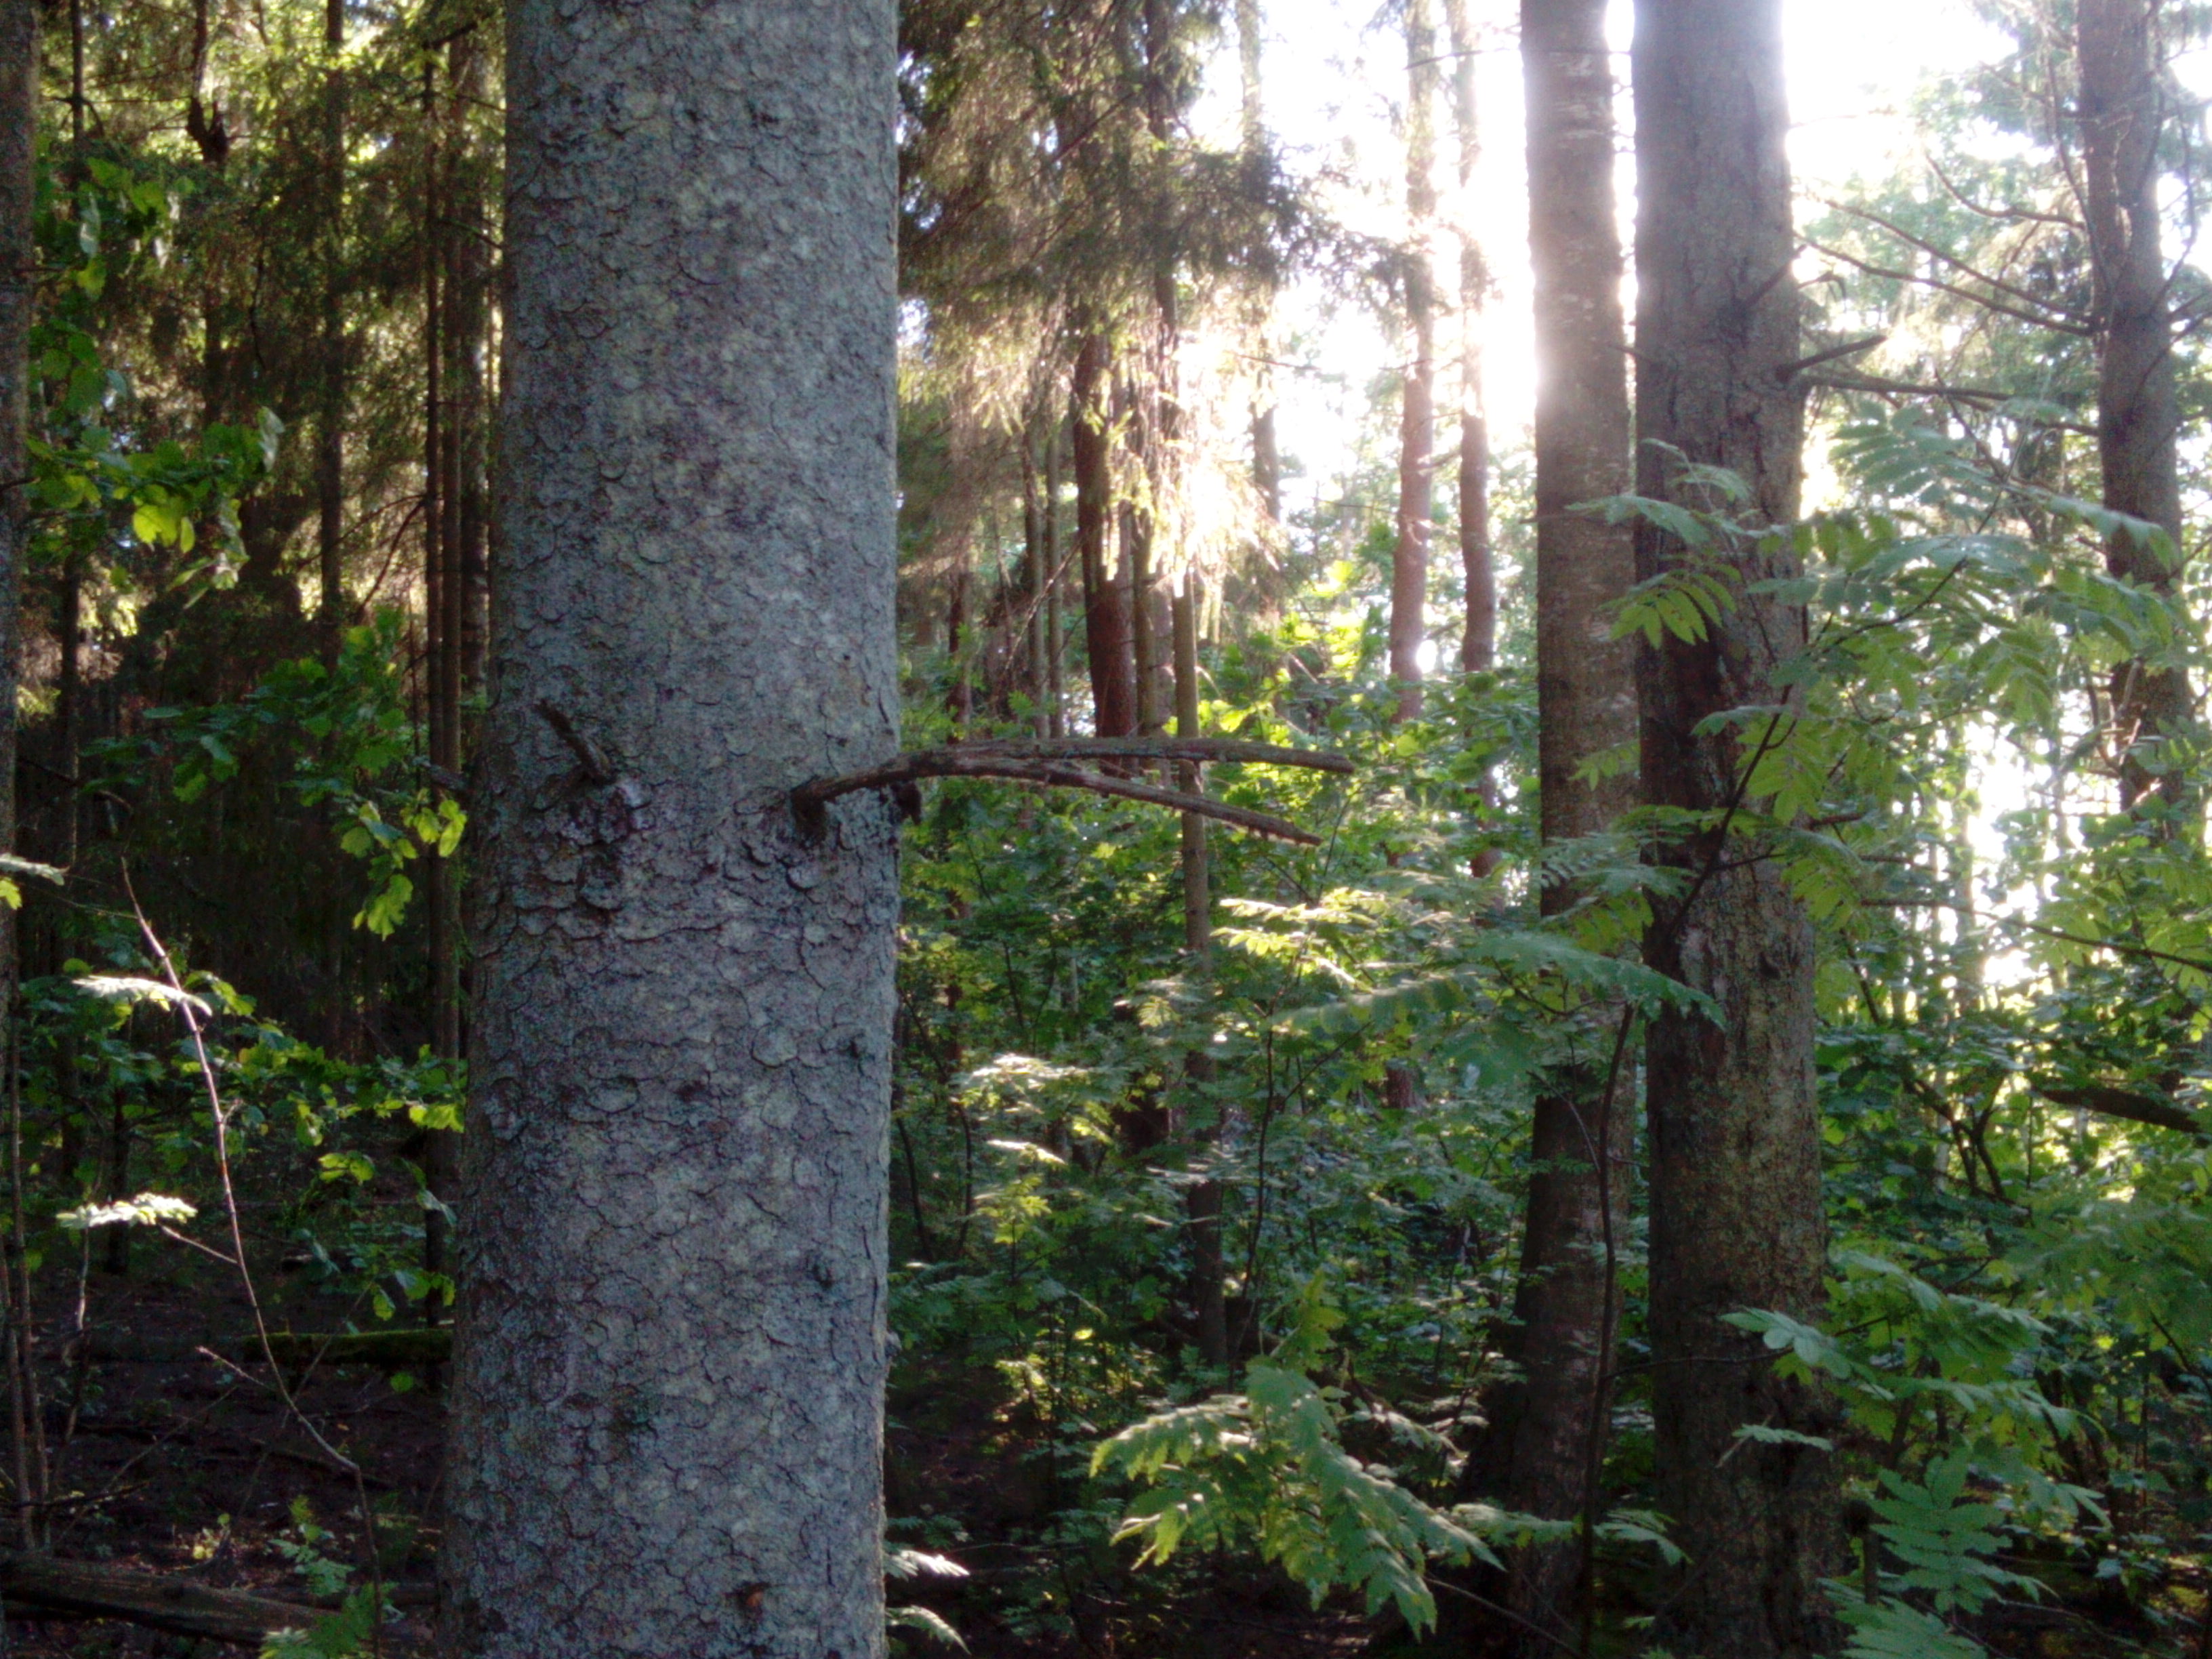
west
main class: Woodland
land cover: Spruce dominated mixed woodland
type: hemiboreal forest and nemoral coniferous forest and mixed broadleaved-coniferous forest
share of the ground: > 75 %
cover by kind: coniferous forest trees 65 %, broadleaved forest trees 25 %, herbaceous plants 5 %, lichens and mosses 5 %
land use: Forestry
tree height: > 5 m
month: July
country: LV
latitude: 56.5056
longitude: 22.0903
